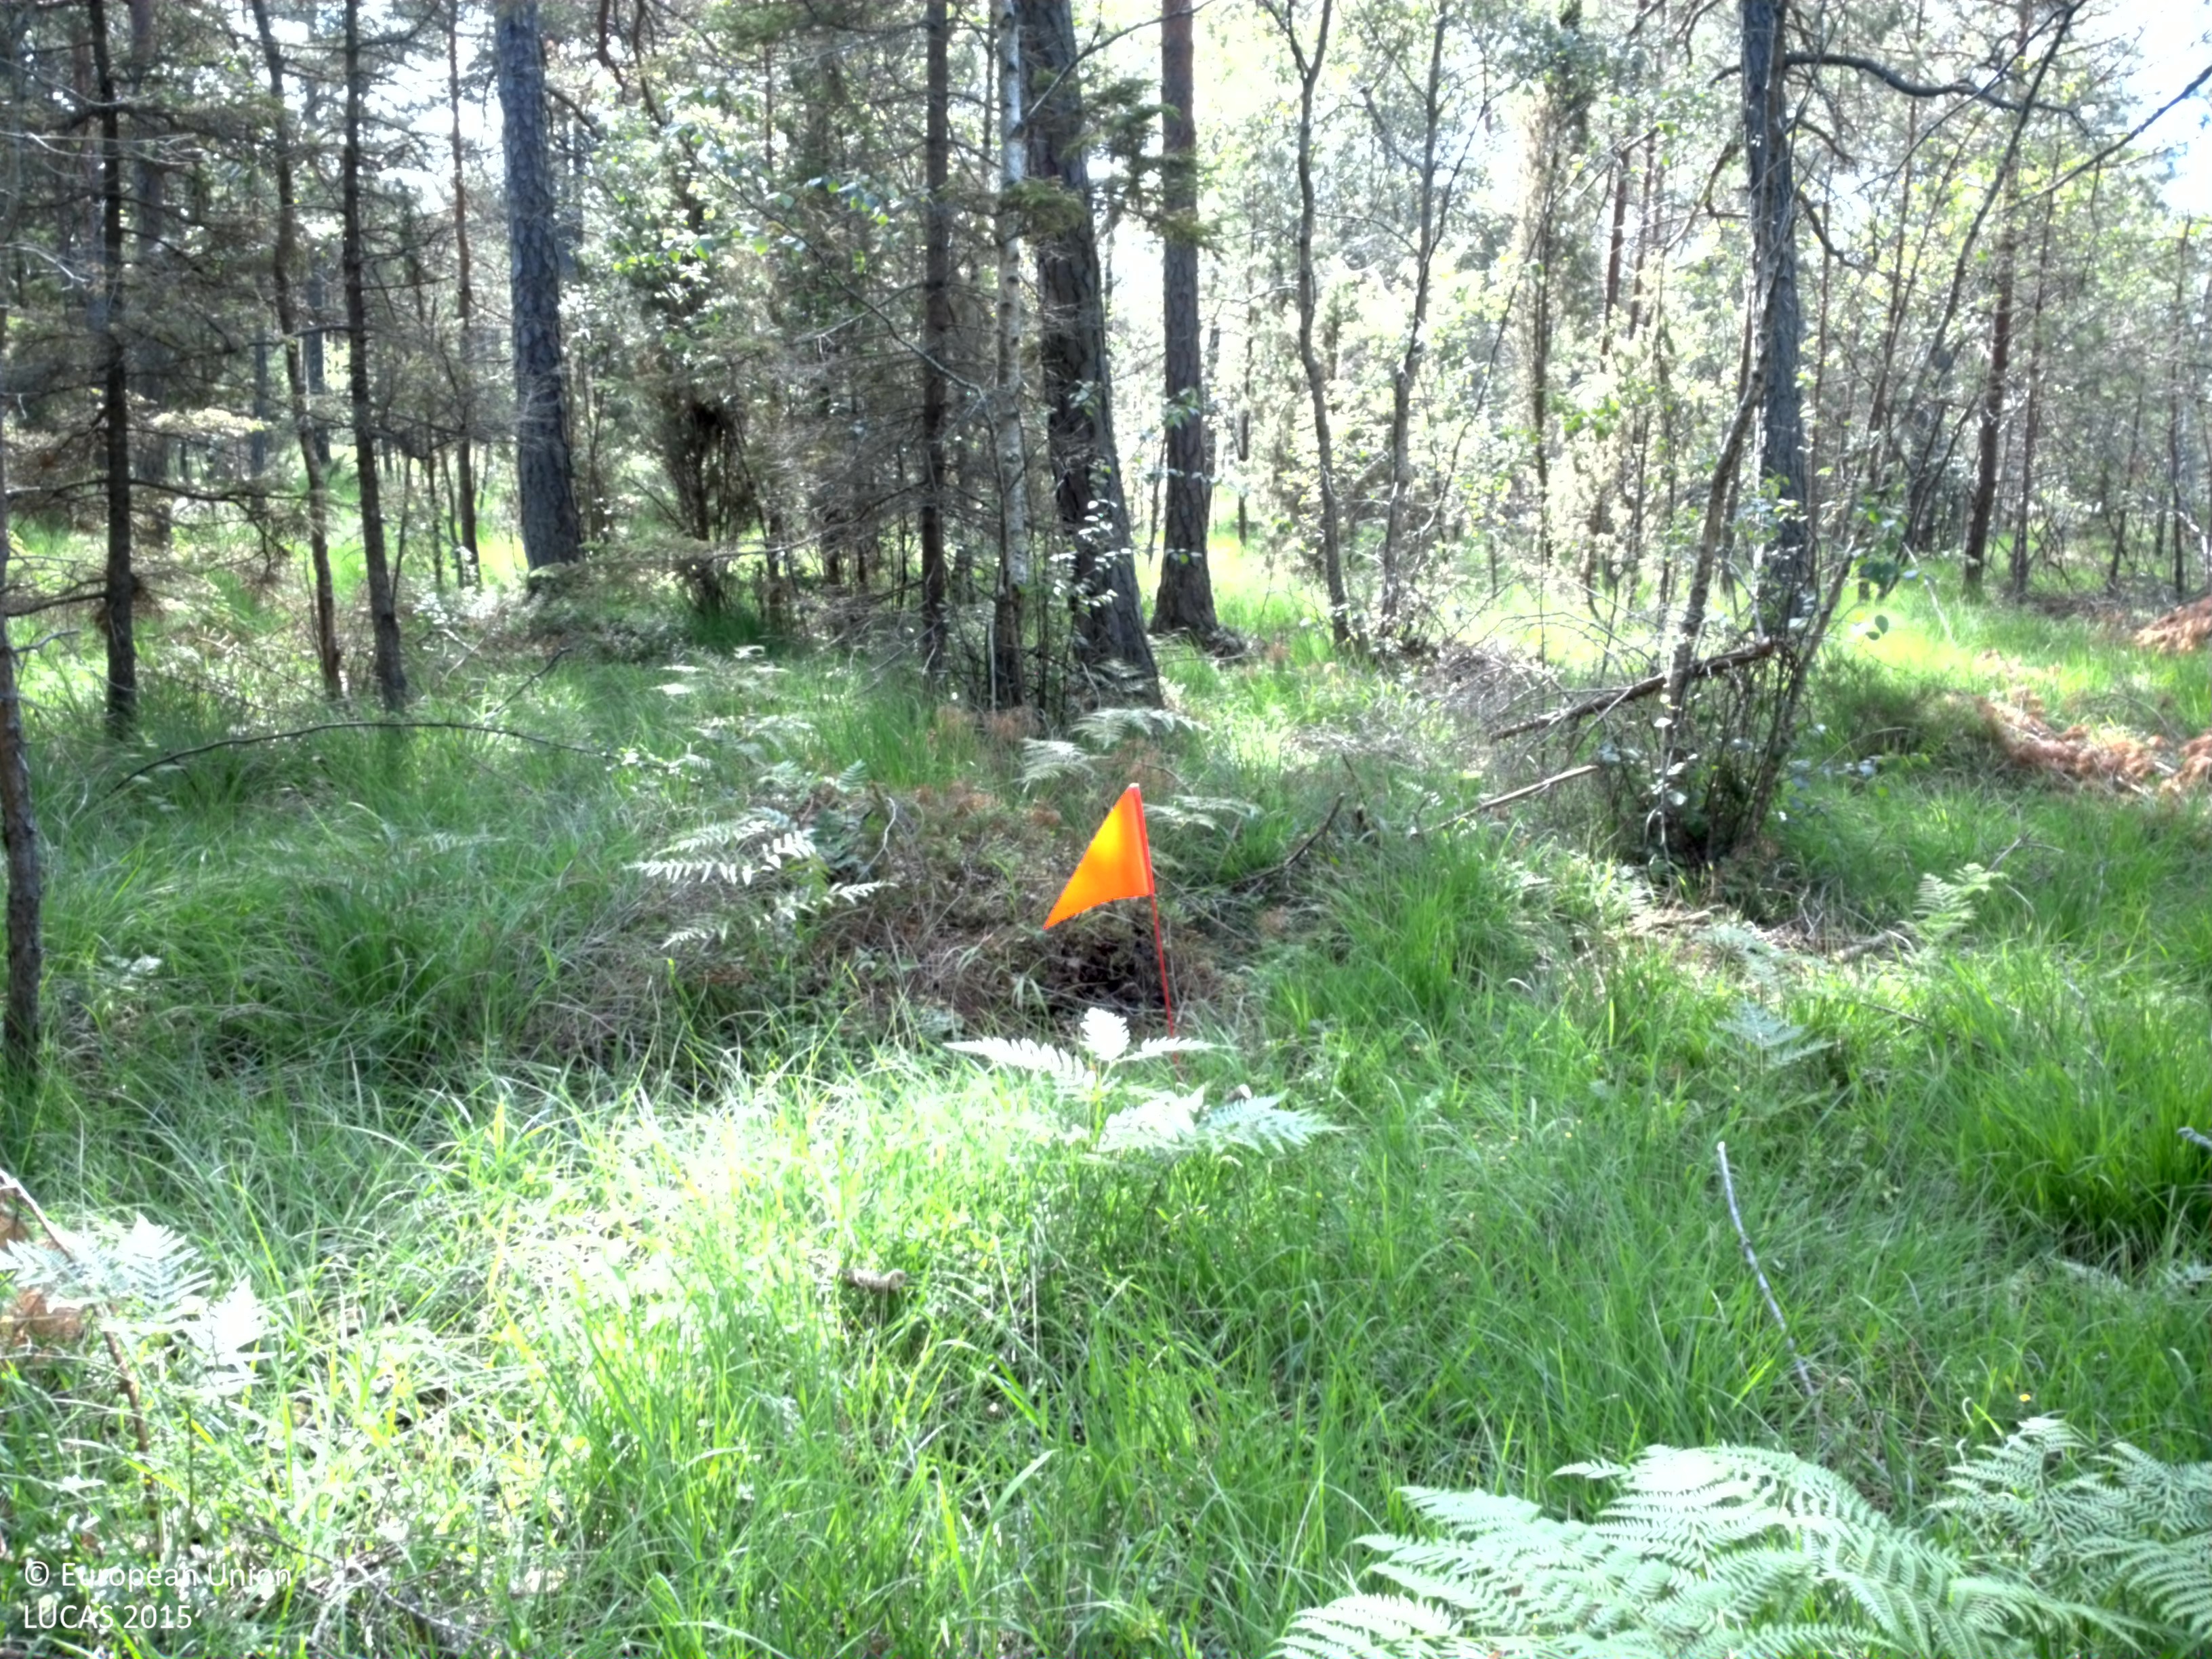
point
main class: Woodland
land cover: Pine dominated mixed woodland
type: hemiboreal forest and nemoral coniferous forest and mixed broadleaved-coniferous forest
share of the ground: 50 - 75 %
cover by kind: herbaceous plants 40 %, coniferous forest trees 35 %, broadleaved forest trees 20 %, shrubs 5 %
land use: Forestry
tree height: > 5 m
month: July
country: SE
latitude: 57.3932
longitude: 18.7125
